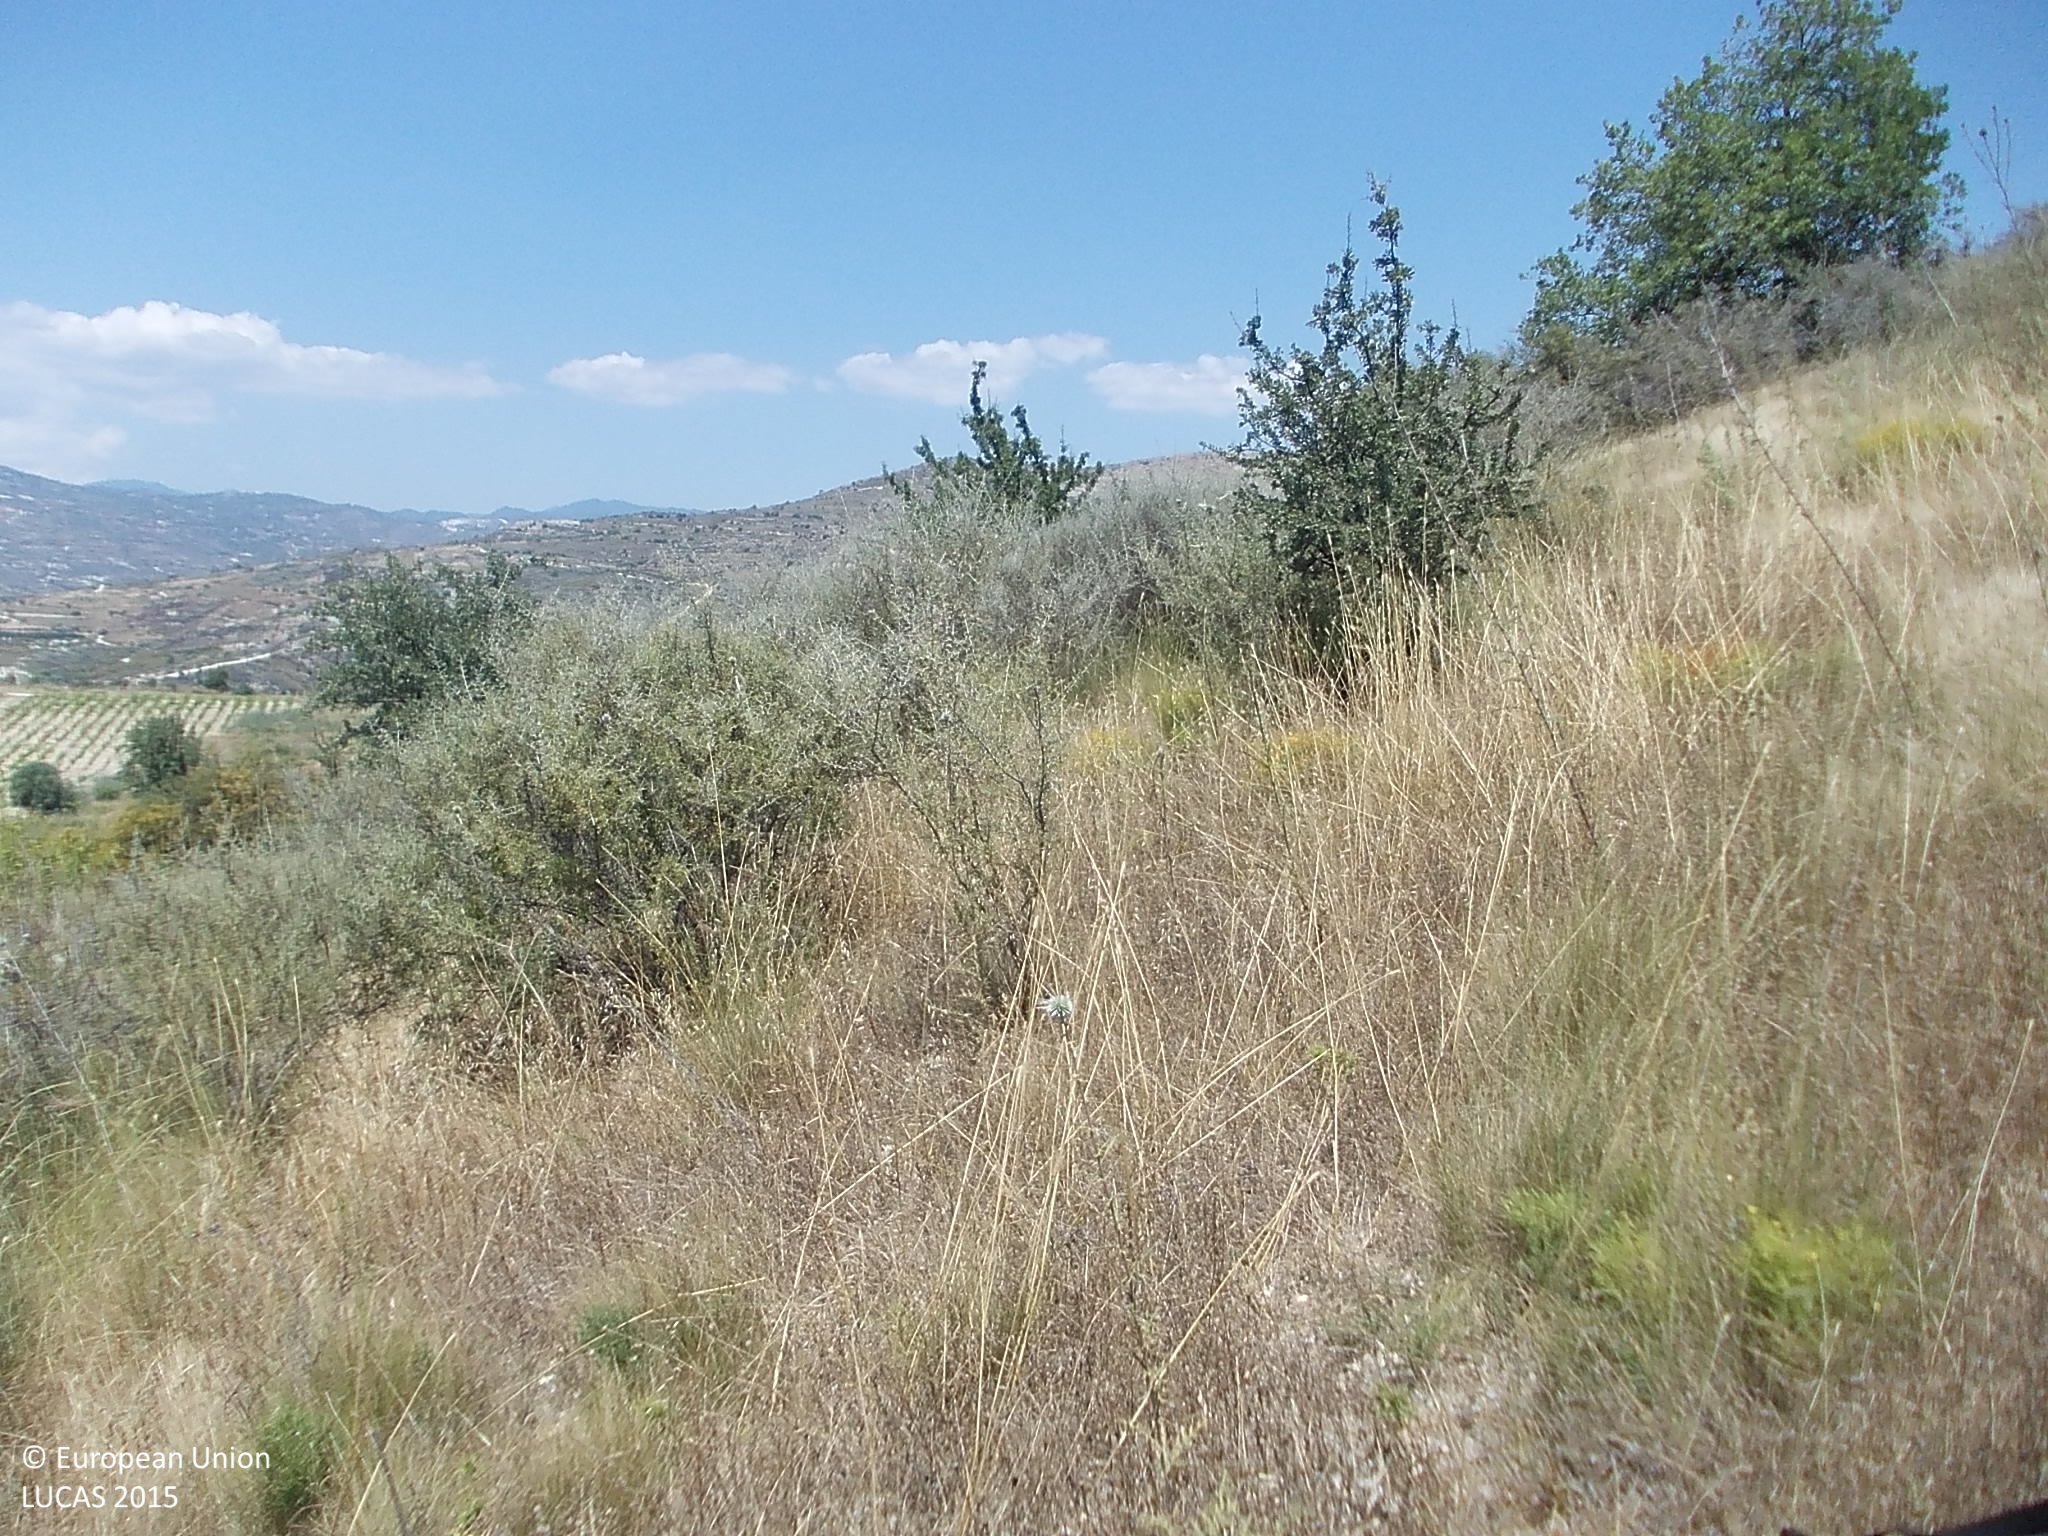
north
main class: Grassland
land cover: Grassland with sparse tree/shrub cover
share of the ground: > 75 %
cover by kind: herbaceous plants 85 %, broadleaved forest trees 5 %, shrubs 5 %, unconsolidated bare surface 5 %
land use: Semi-natural and natural areas not in use
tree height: < 5 m
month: July
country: CY
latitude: 34.8064
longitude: 32.7297
